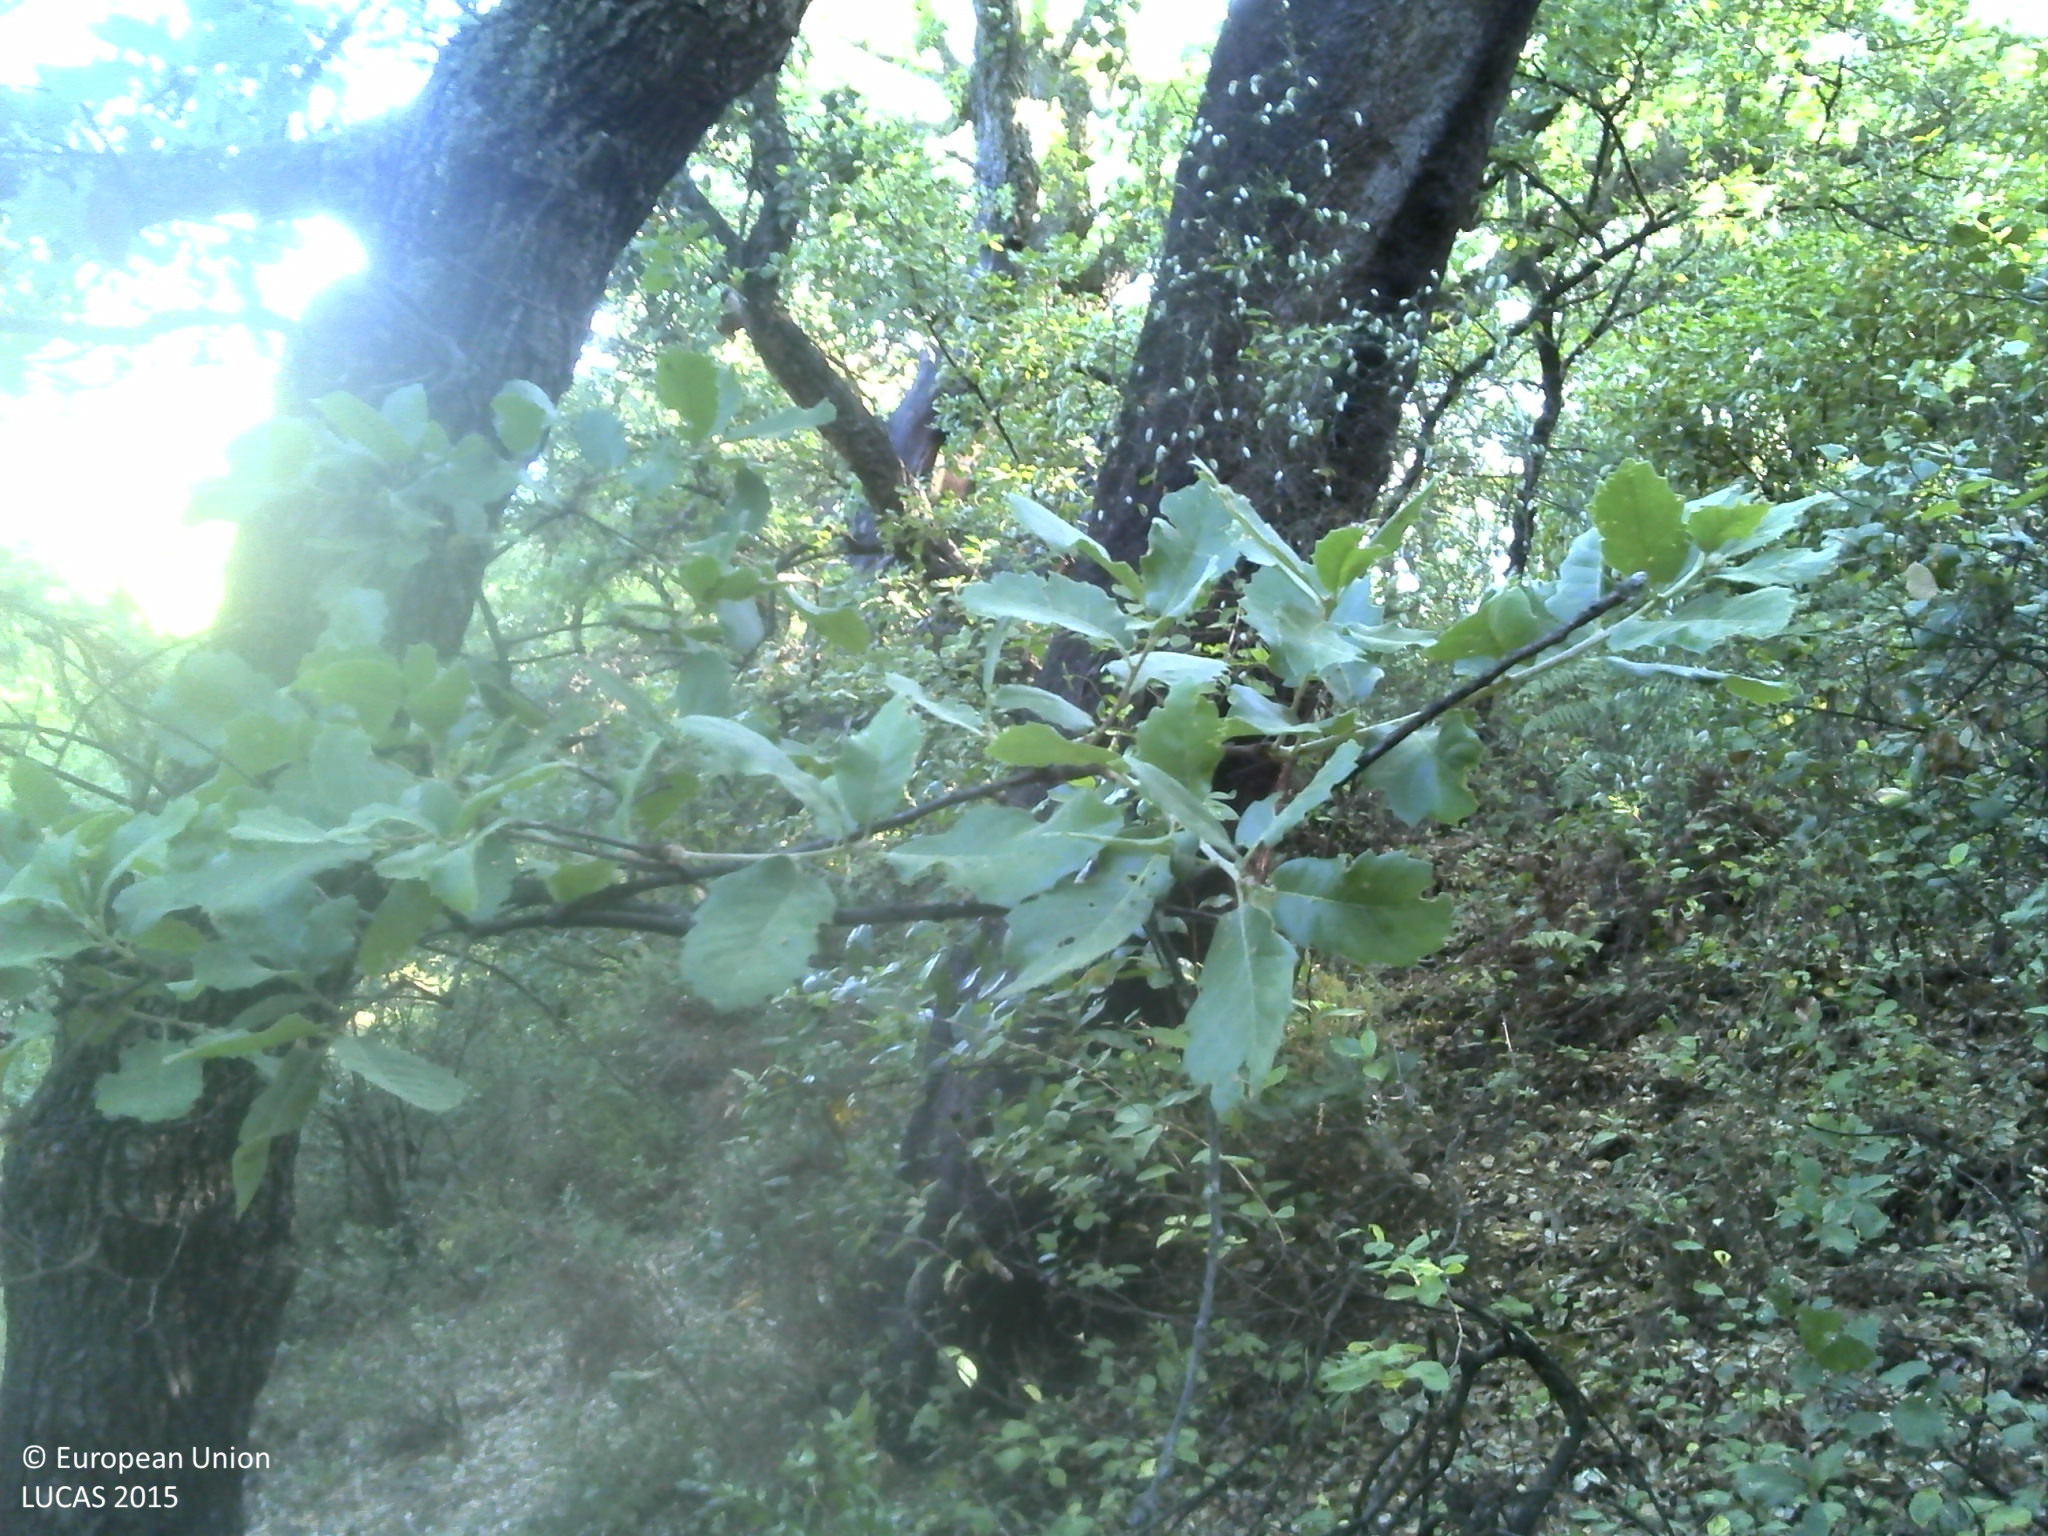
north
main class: Woodland
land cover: Broadleaved woodland
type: mesophytic deciduous forest
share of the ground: 50 - 75 %
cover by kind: broadleaved forest trees 75 %, shrubs 10 %, coniferous forest trees 5 %, herbaceous plants 5 %, unconsolidated bare surface 5 %
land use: Forestry
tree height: > 5 m
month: May
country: PT
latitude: 39.4674
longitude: -8.3278
